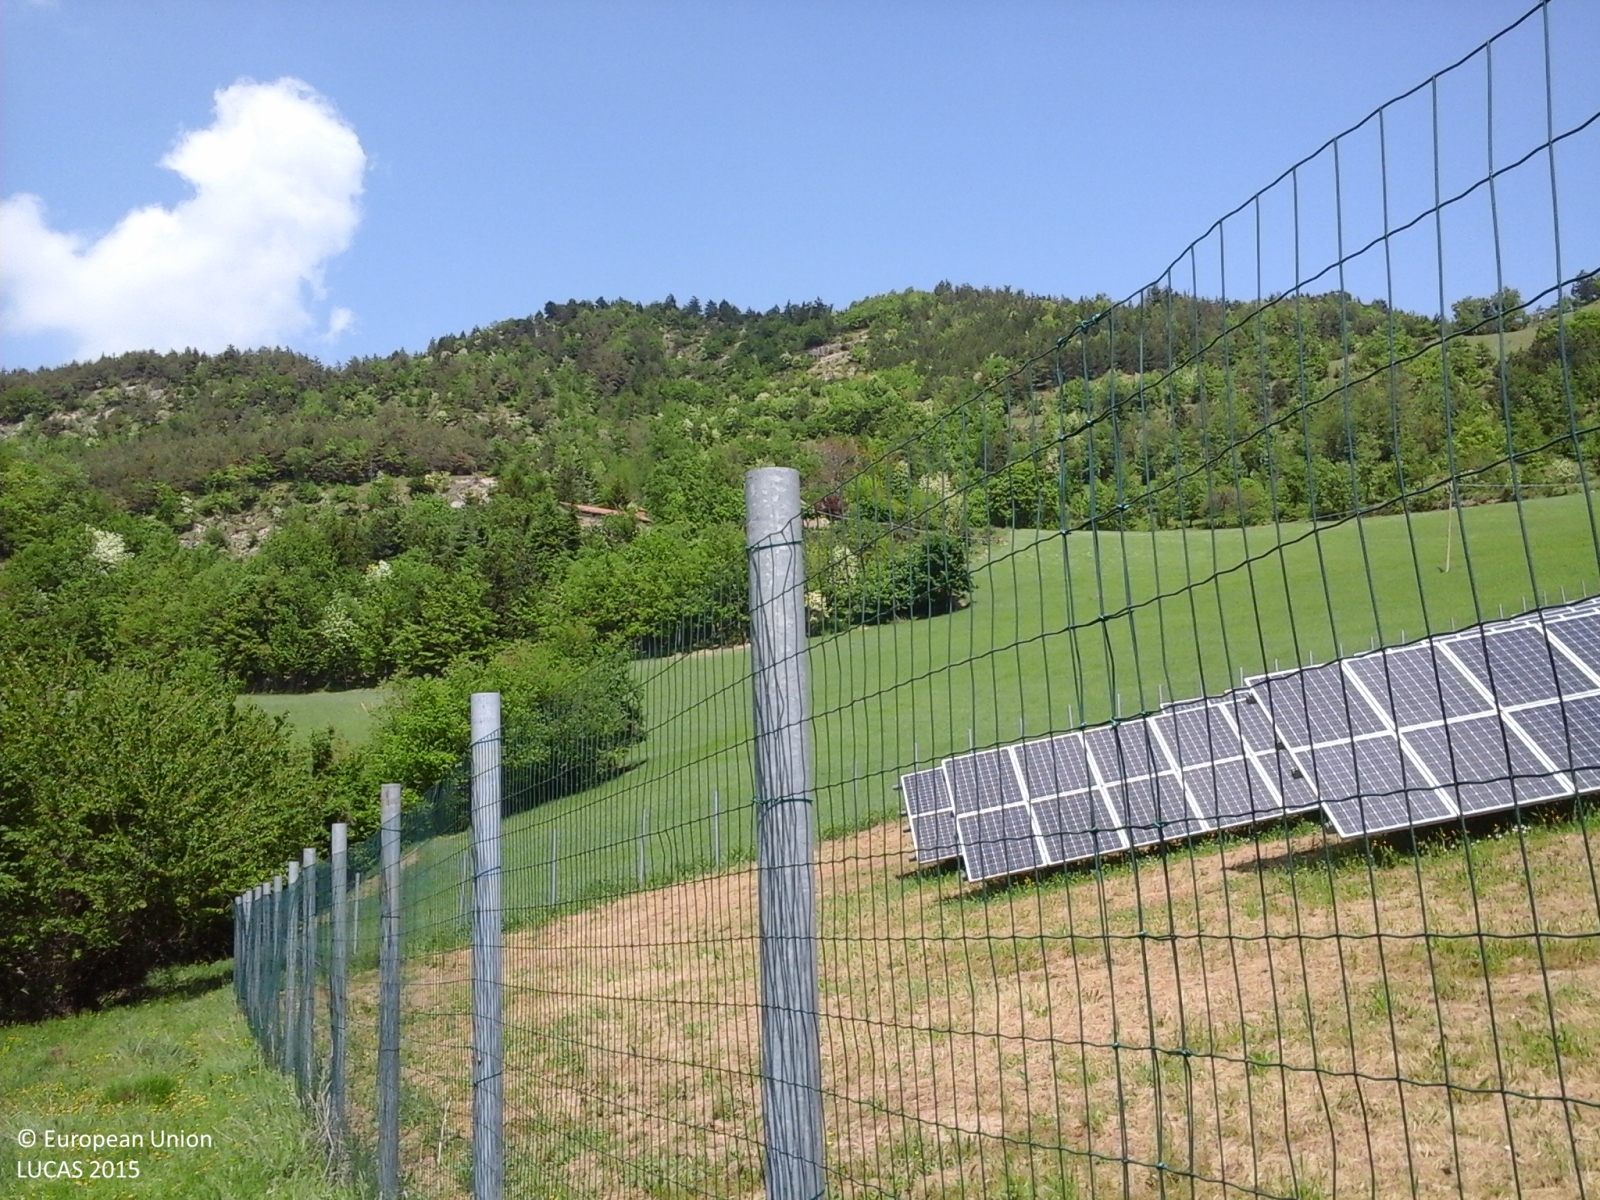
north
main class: Grassland
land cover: Grassland without tree/shrub cover
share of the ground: > 75 %
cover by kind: herbaceous plants 100 %
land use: Energy production
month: May
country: IT
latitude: 43.9371
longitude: 11.8517
